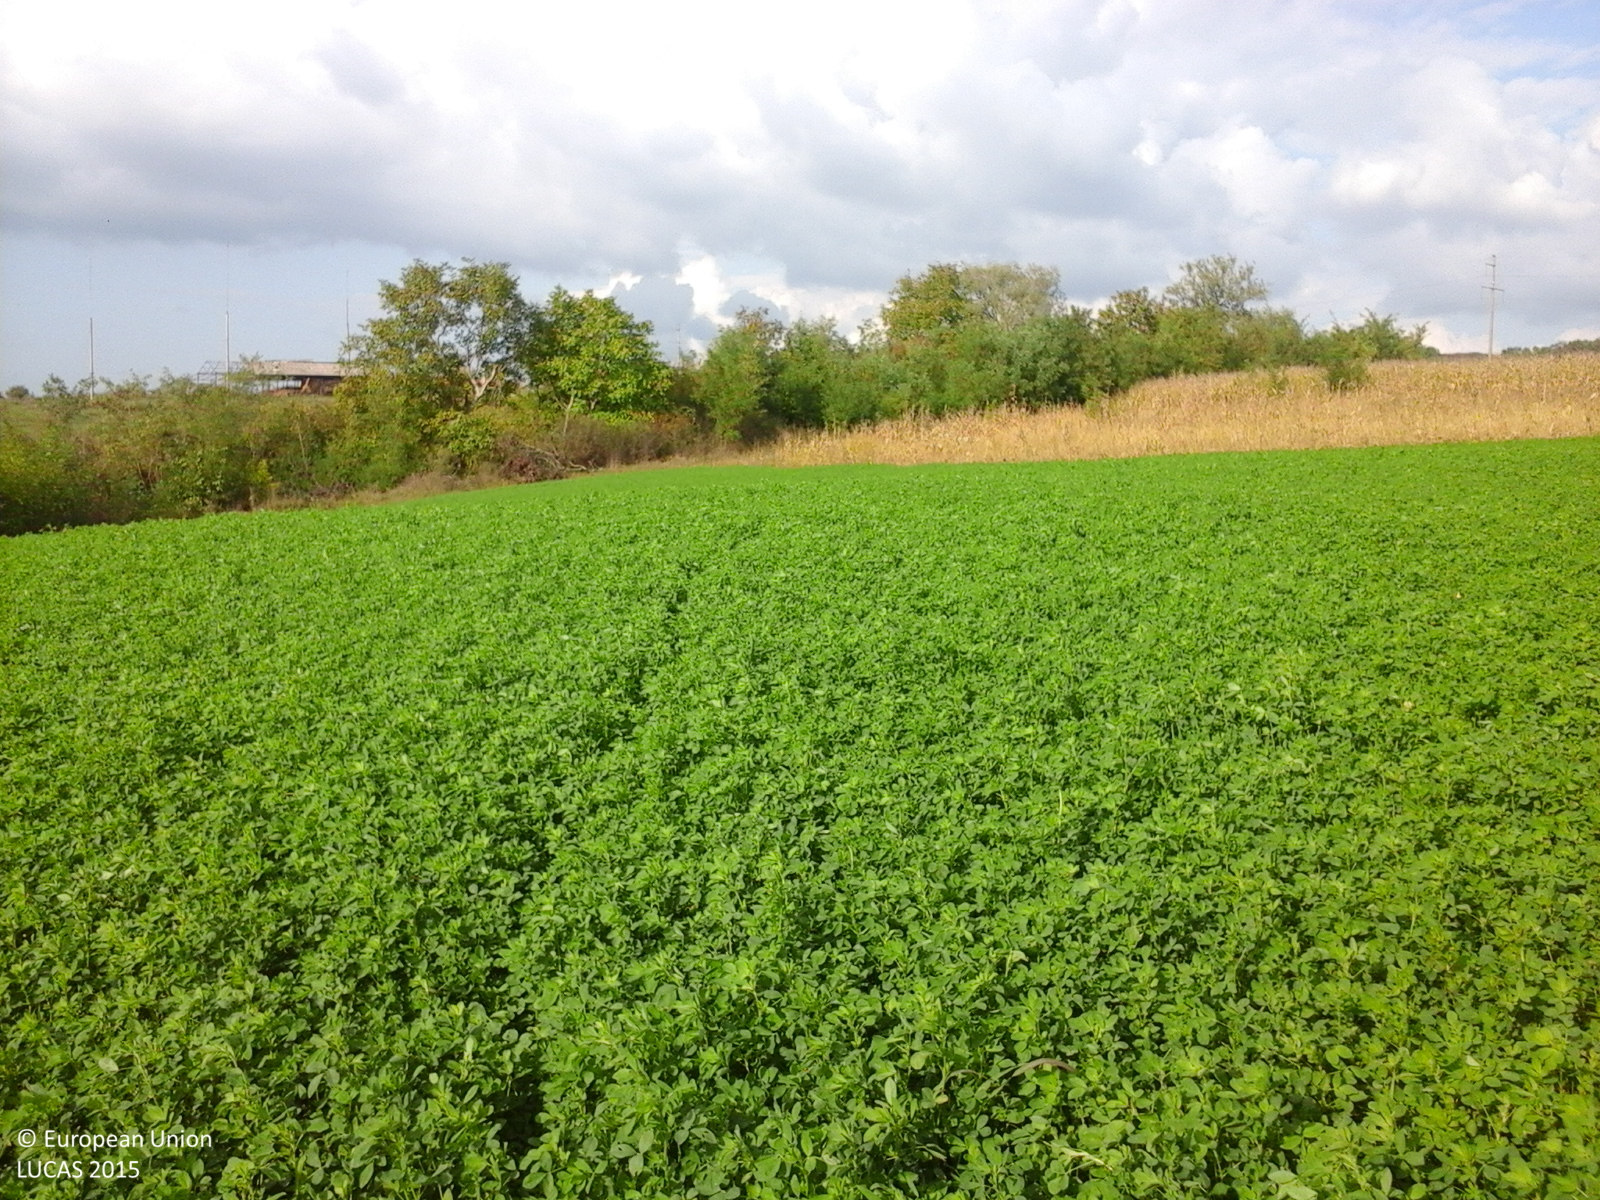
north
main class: Cropland
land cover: Lucerne
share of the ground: > 75 %
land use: Agriculture (excluding fallow land and kitchen gardens)
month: October
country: RO
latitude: 46.2458
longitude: 24.2828
